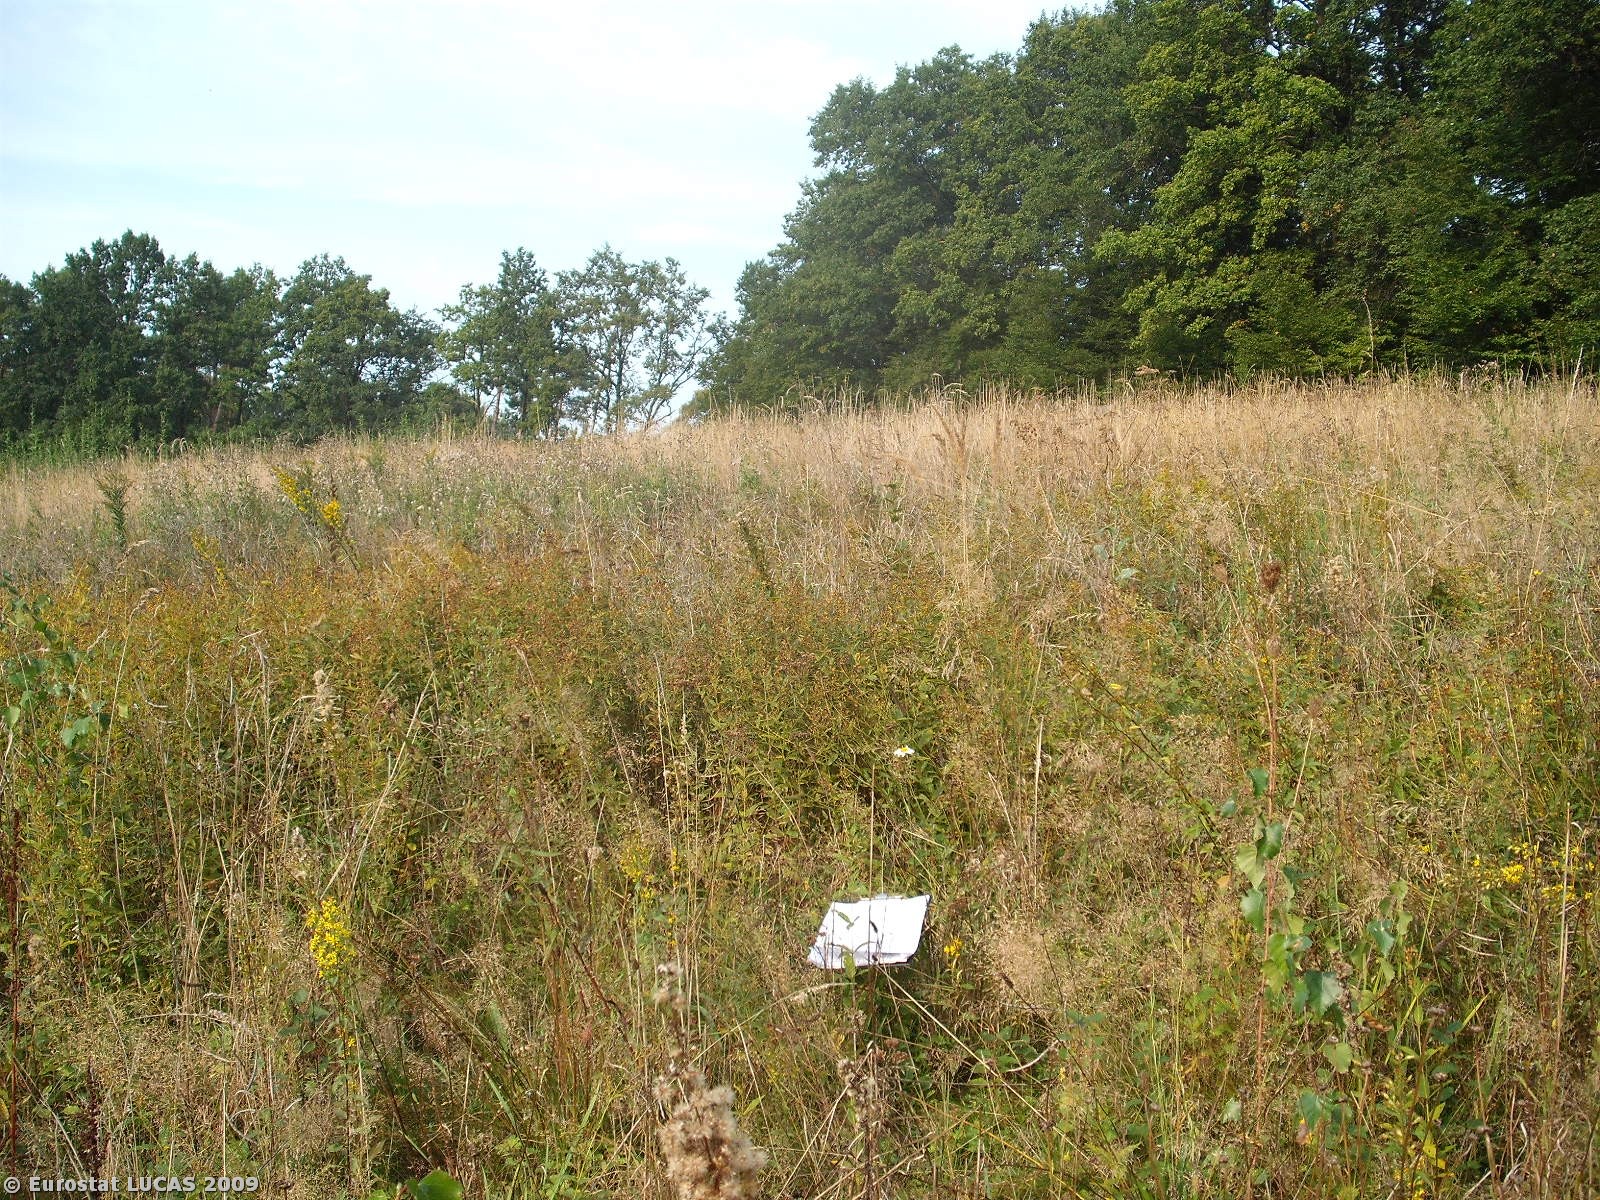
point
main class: Grassland
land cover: Grassland with sparse tree/shrub cover
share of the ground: > 75 %
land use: Unused
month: September
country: PL
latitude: 49.7159
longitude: 21.0702
